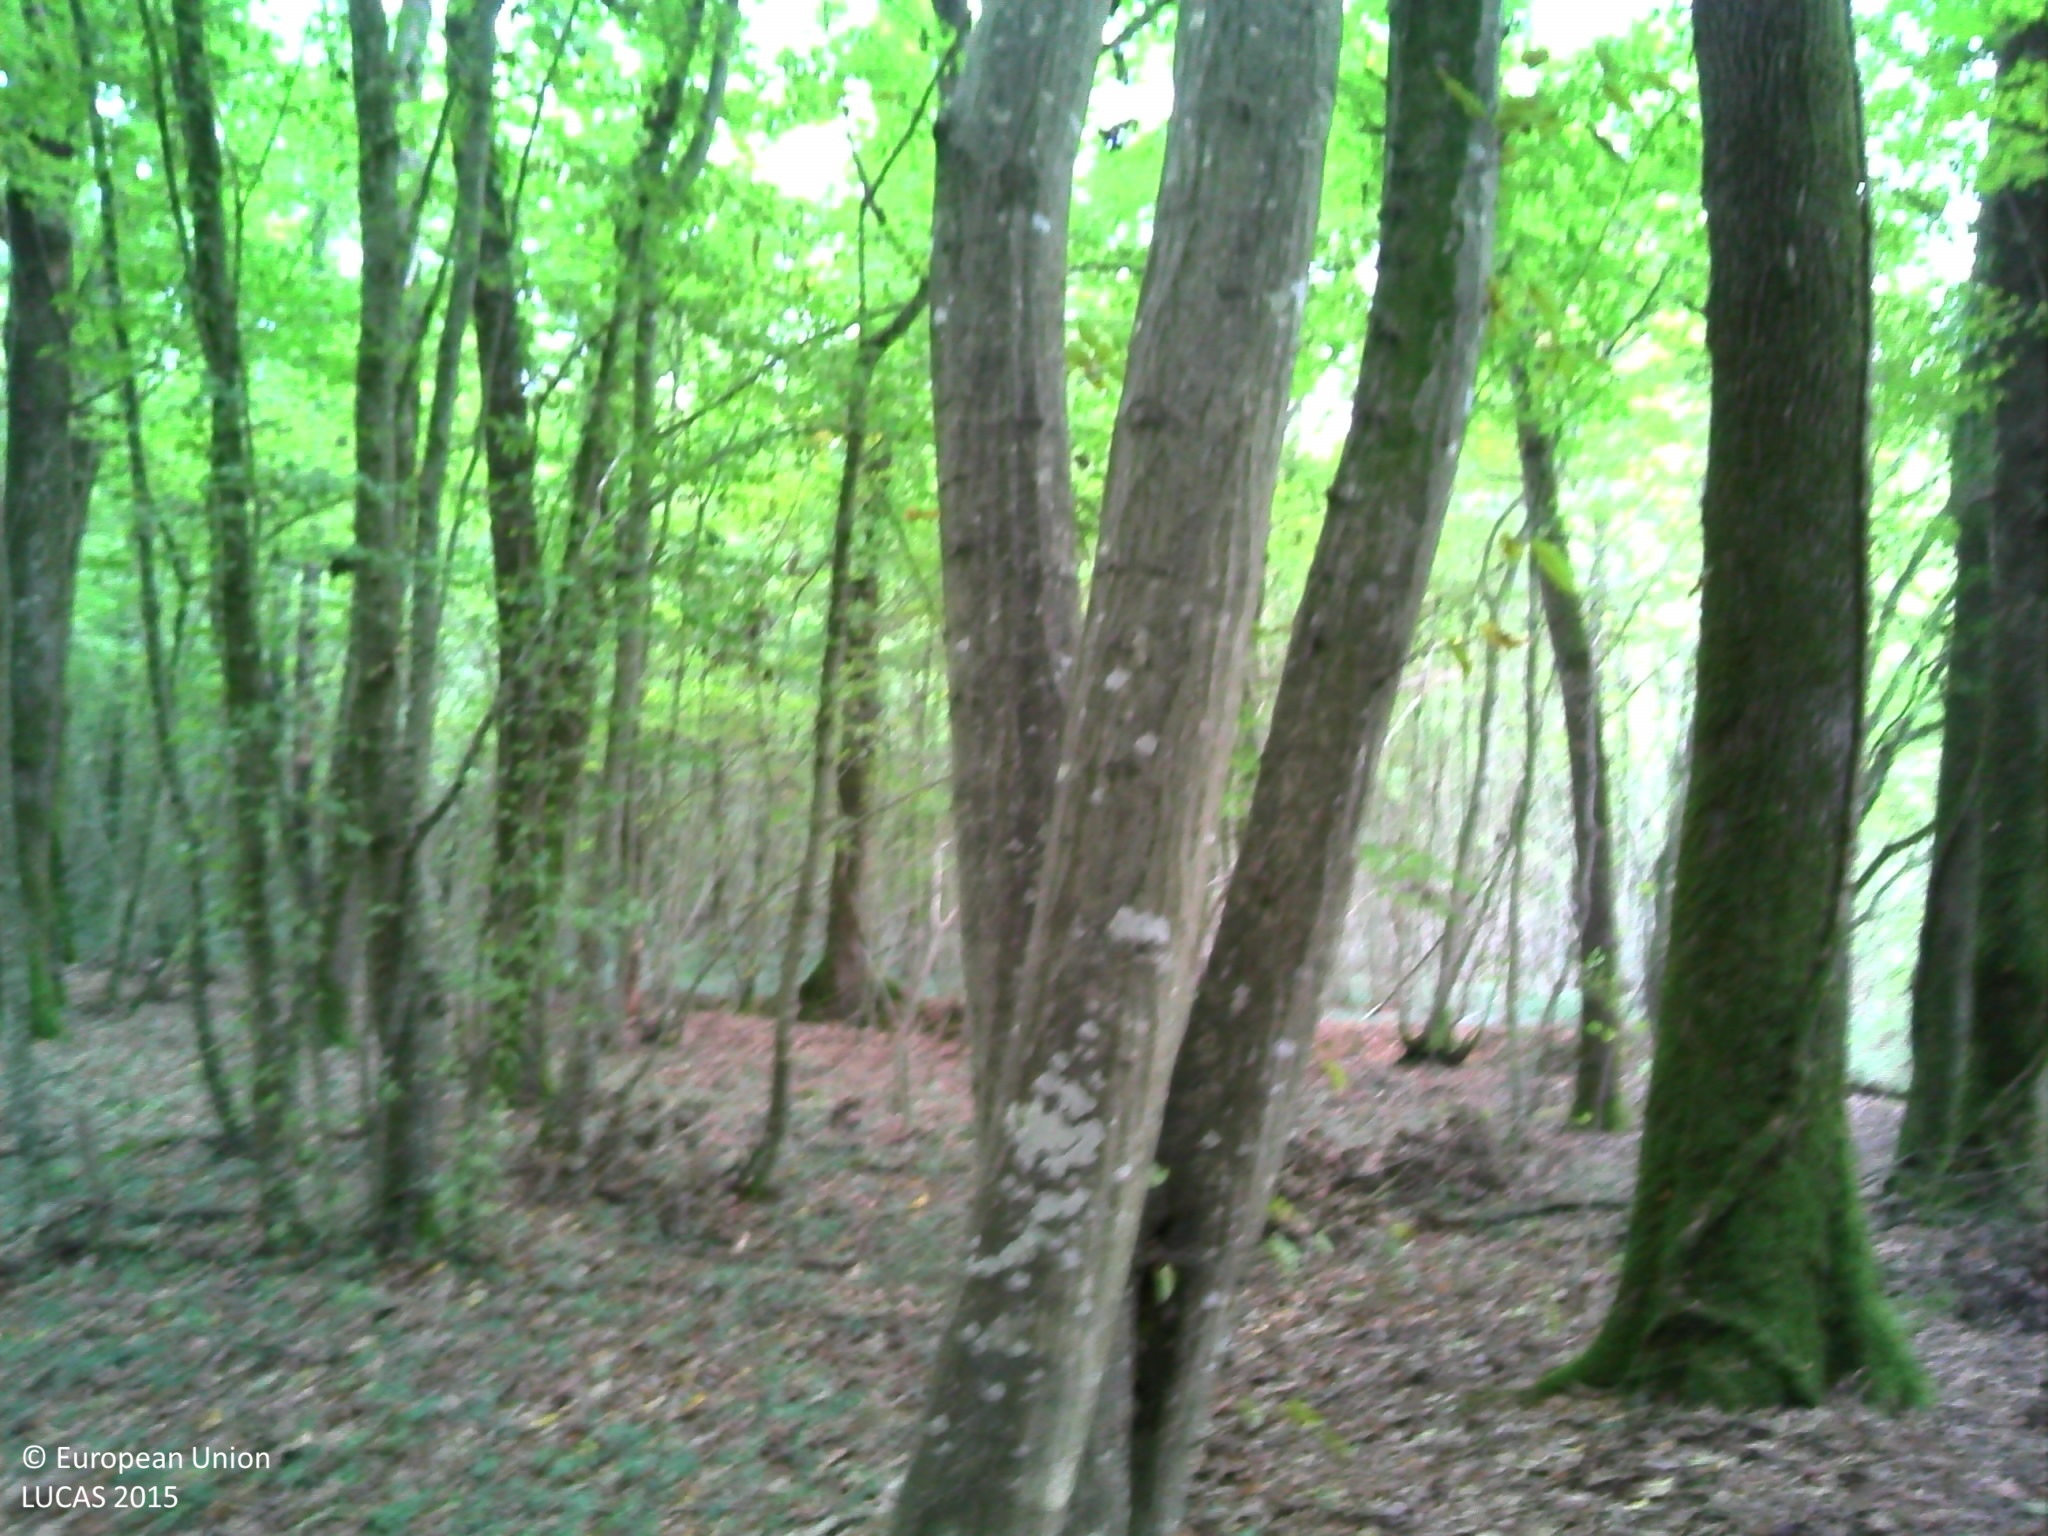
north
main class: Woodland
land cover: Broadleaved woodland
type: mesophytic deciduous forest
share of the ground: > 75 %
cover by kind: broadleaved forest trees 95 %, herbaceous plants 5 %
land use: Forestry
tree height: > 5 m
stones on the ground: < 10 %
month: October
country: FR
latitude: 46.2587
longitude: 5.1379
